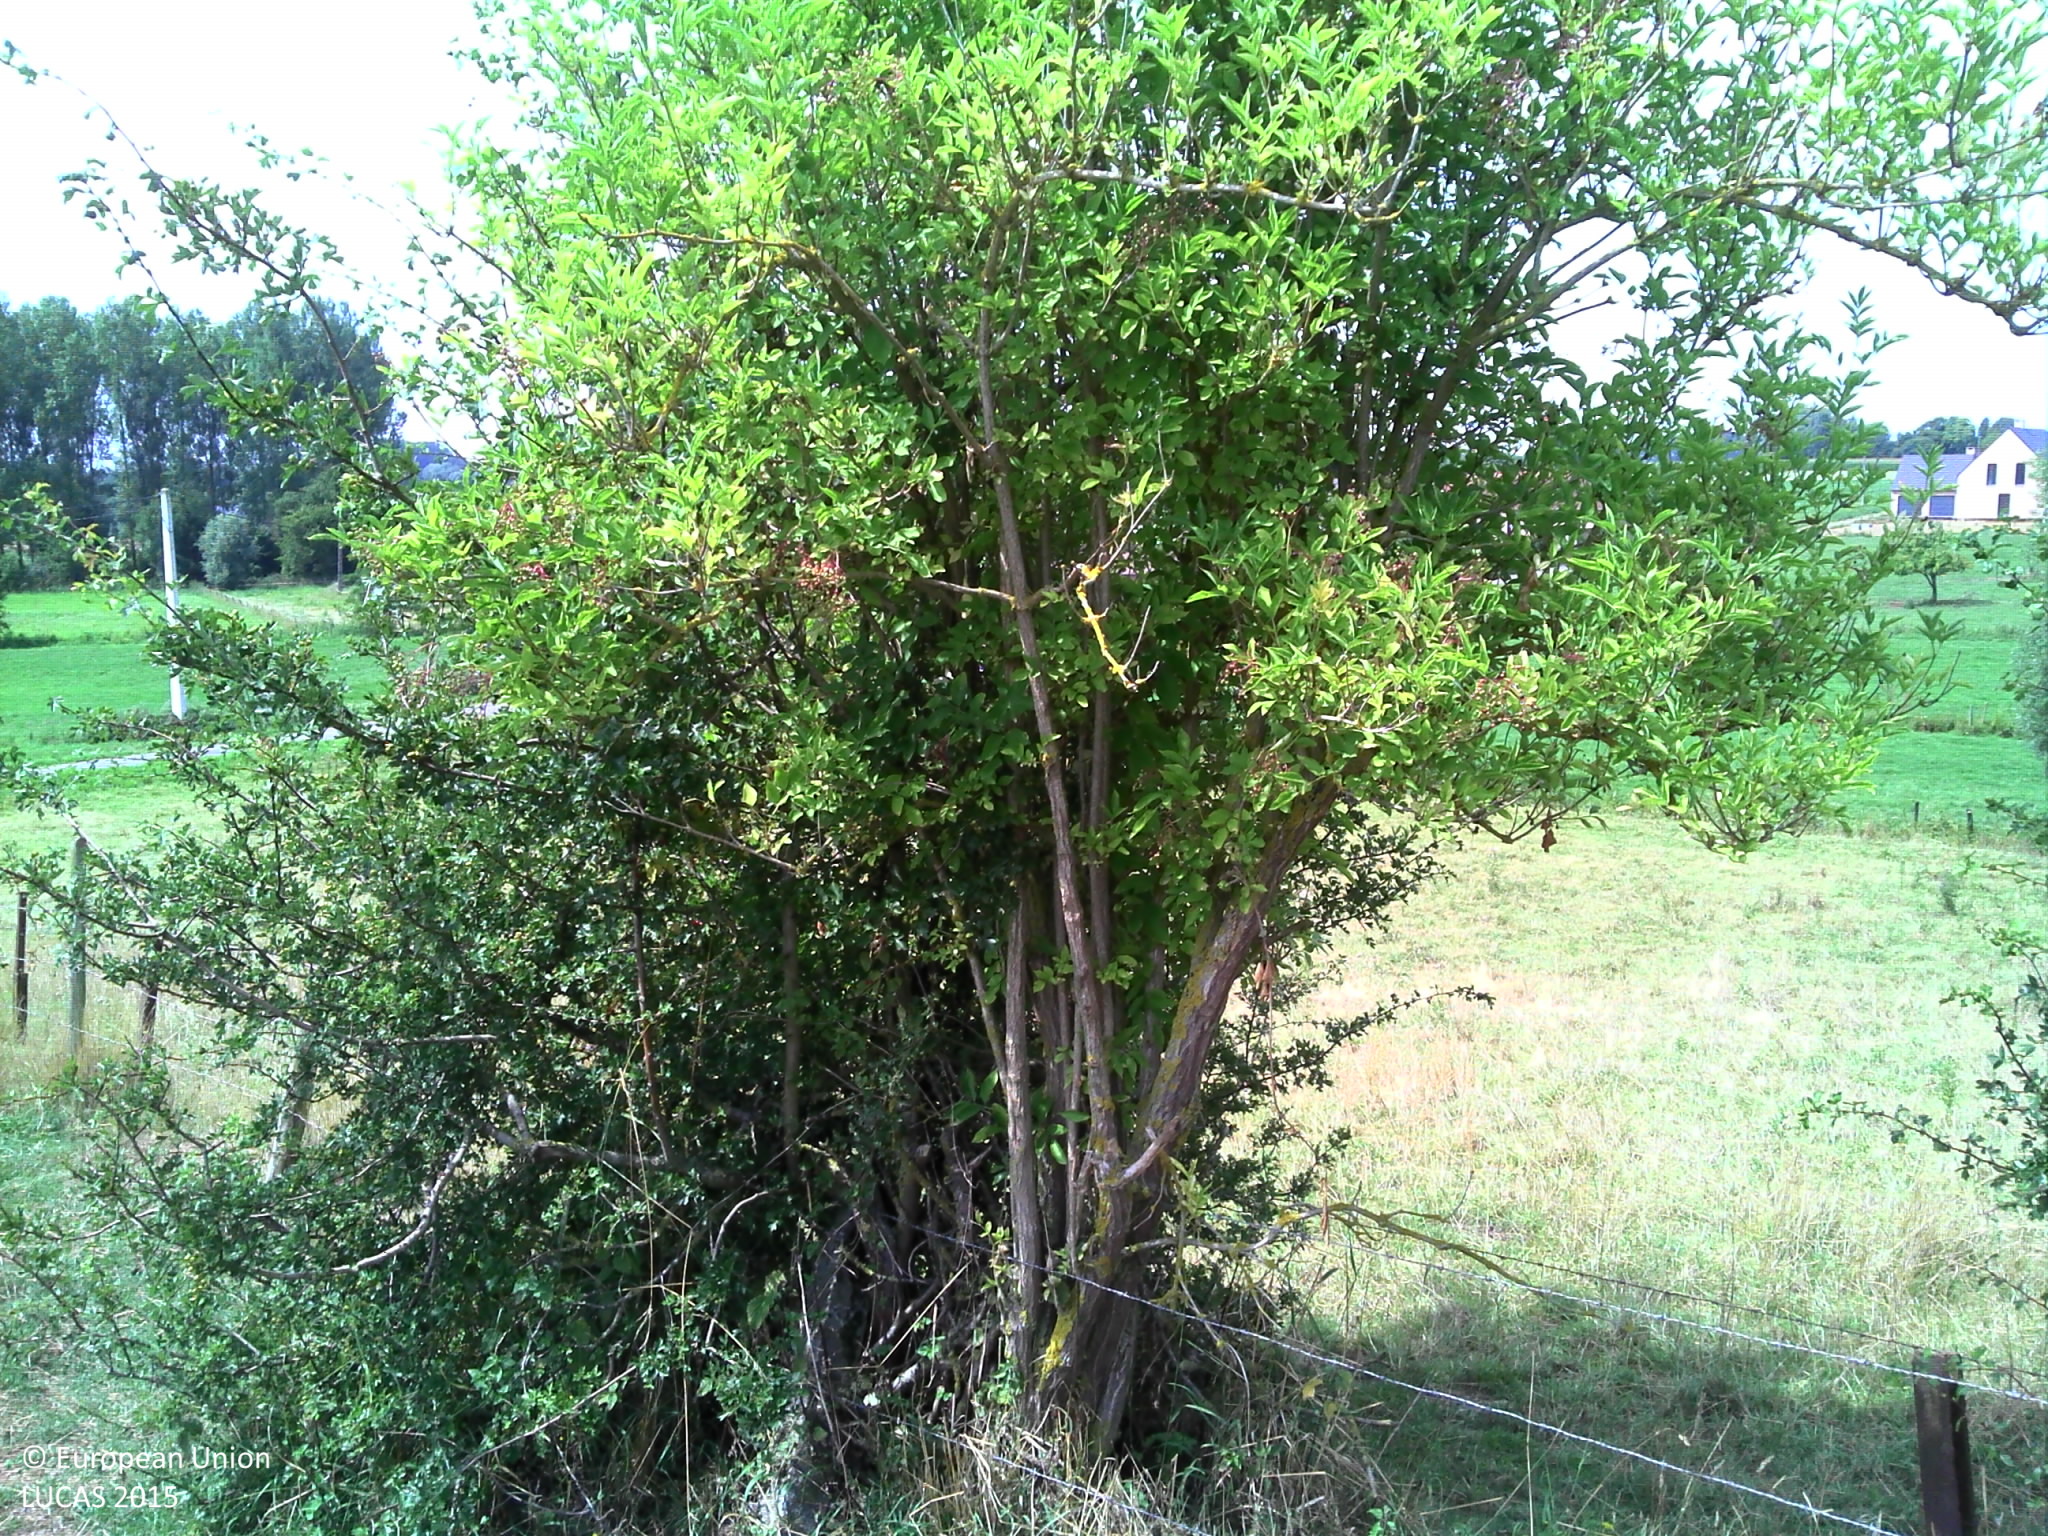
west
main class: Grassland
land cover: Grassland without tree/shrub cover
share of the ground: > 75 %
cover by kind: herbaceous plants 100 %
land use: Agriculture (excluding fallow land and kitchen gardens)
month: August
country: BE
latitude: 50.7354
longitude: 3.7731
